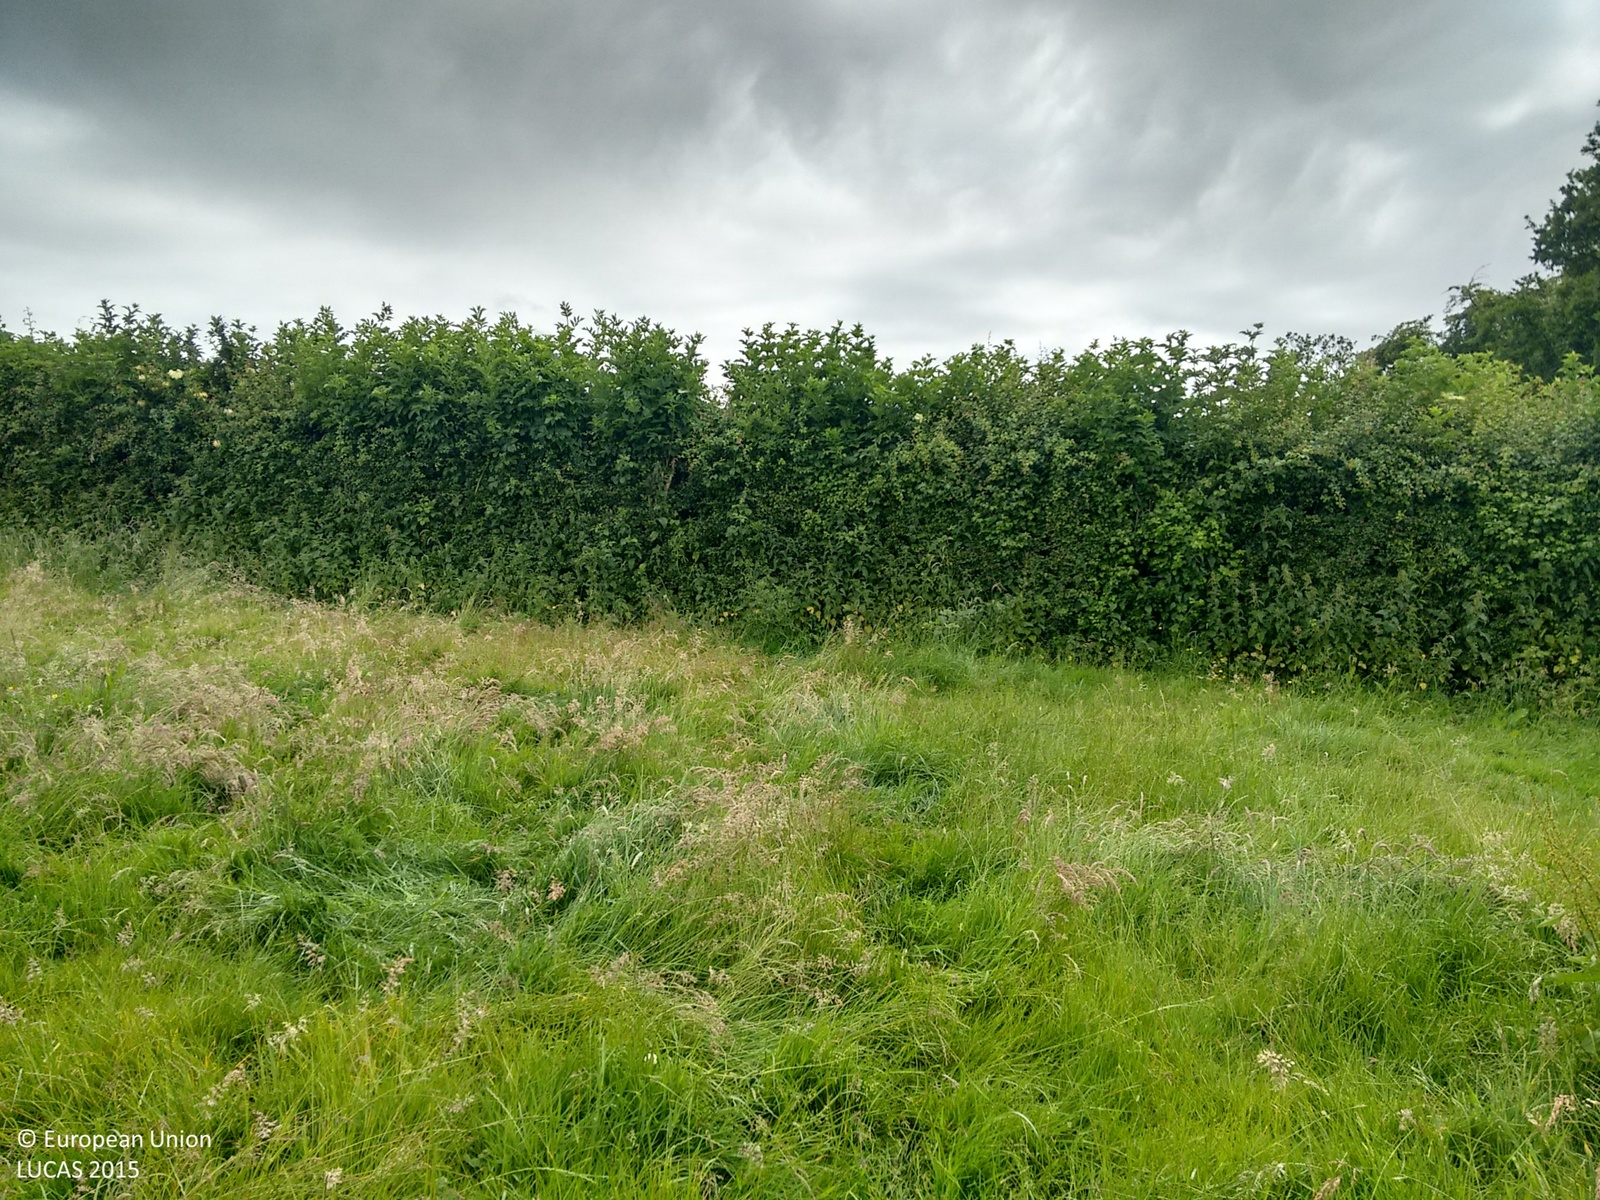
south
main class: Grassland
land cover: Grassland without tree/shrub cover
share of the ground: > 75 %
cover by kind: herbaceous plants 100 %
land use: Agriculture (excluding fallow land and kitchen gardens)
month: June
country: GB
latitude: 50.9273
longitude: 0.2812
